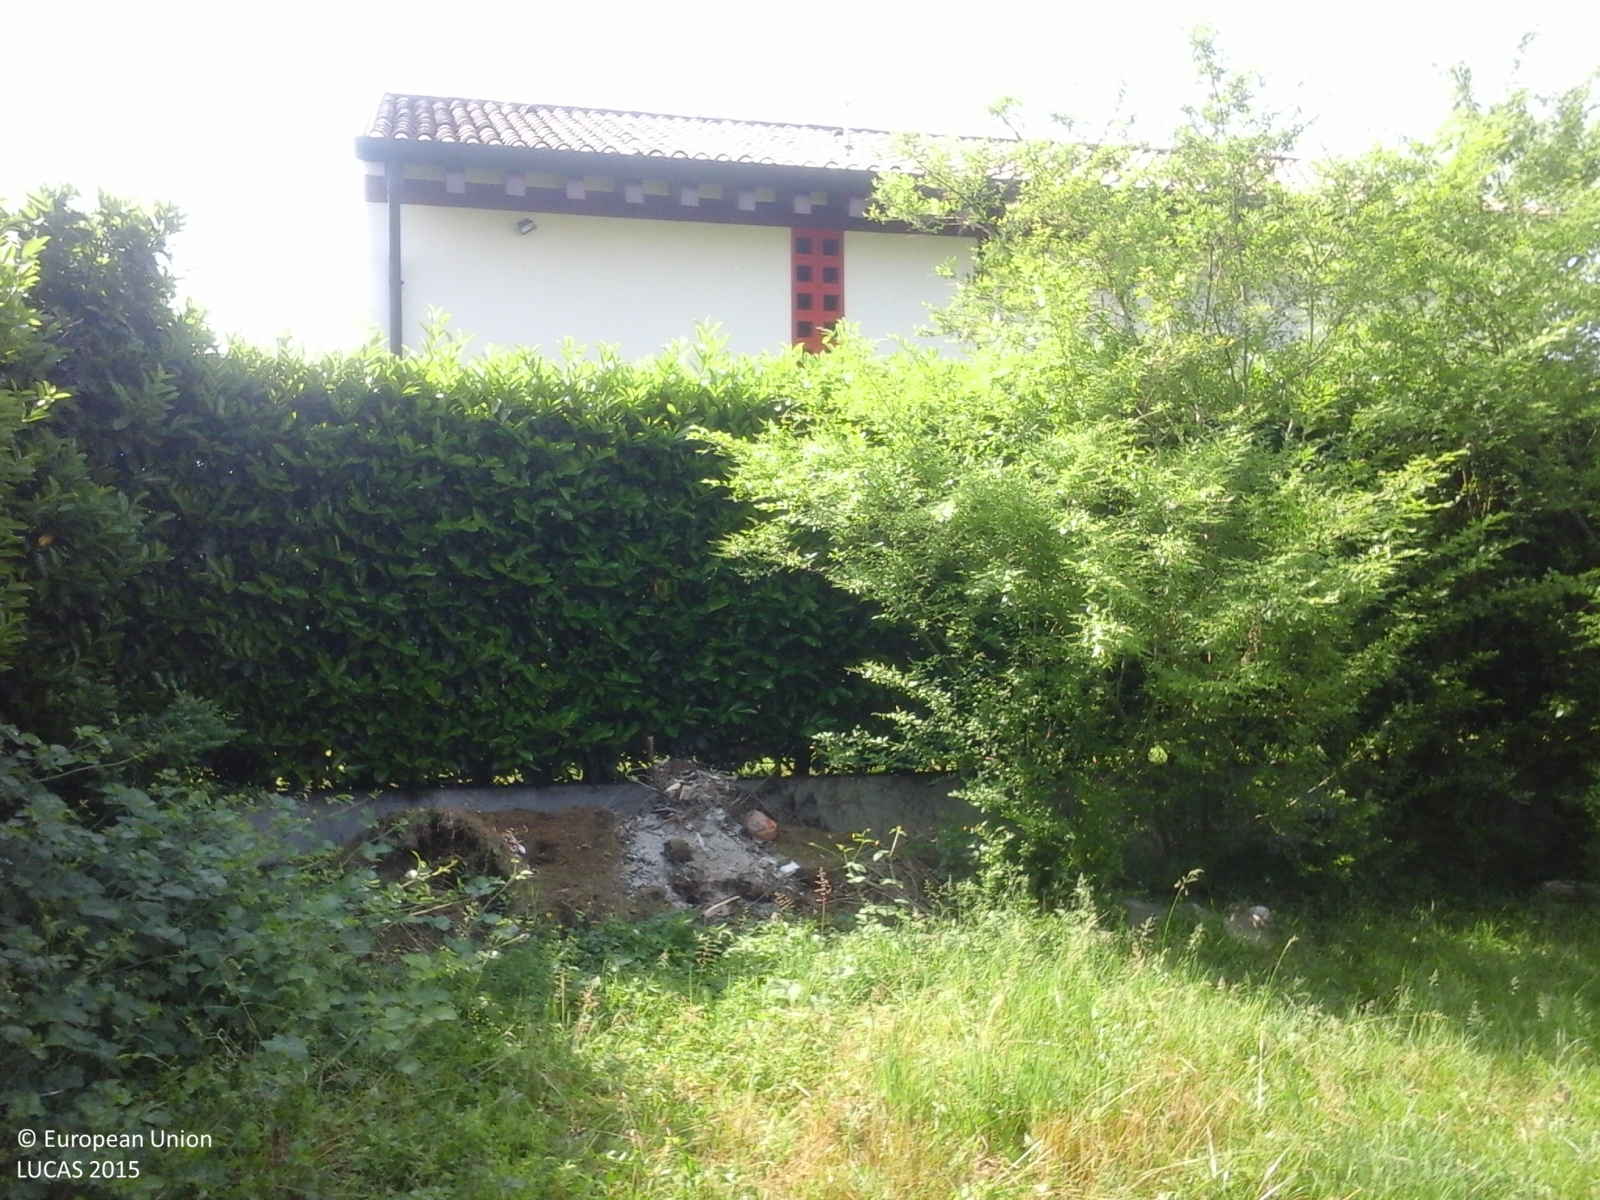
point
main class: Grassland
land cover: Grassland without tree/shrub cover
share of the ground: > 75 %
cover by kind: herbaceous plants 100 %
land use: Residential
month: May
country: IT
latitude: 45.6863
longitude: 11.8590
